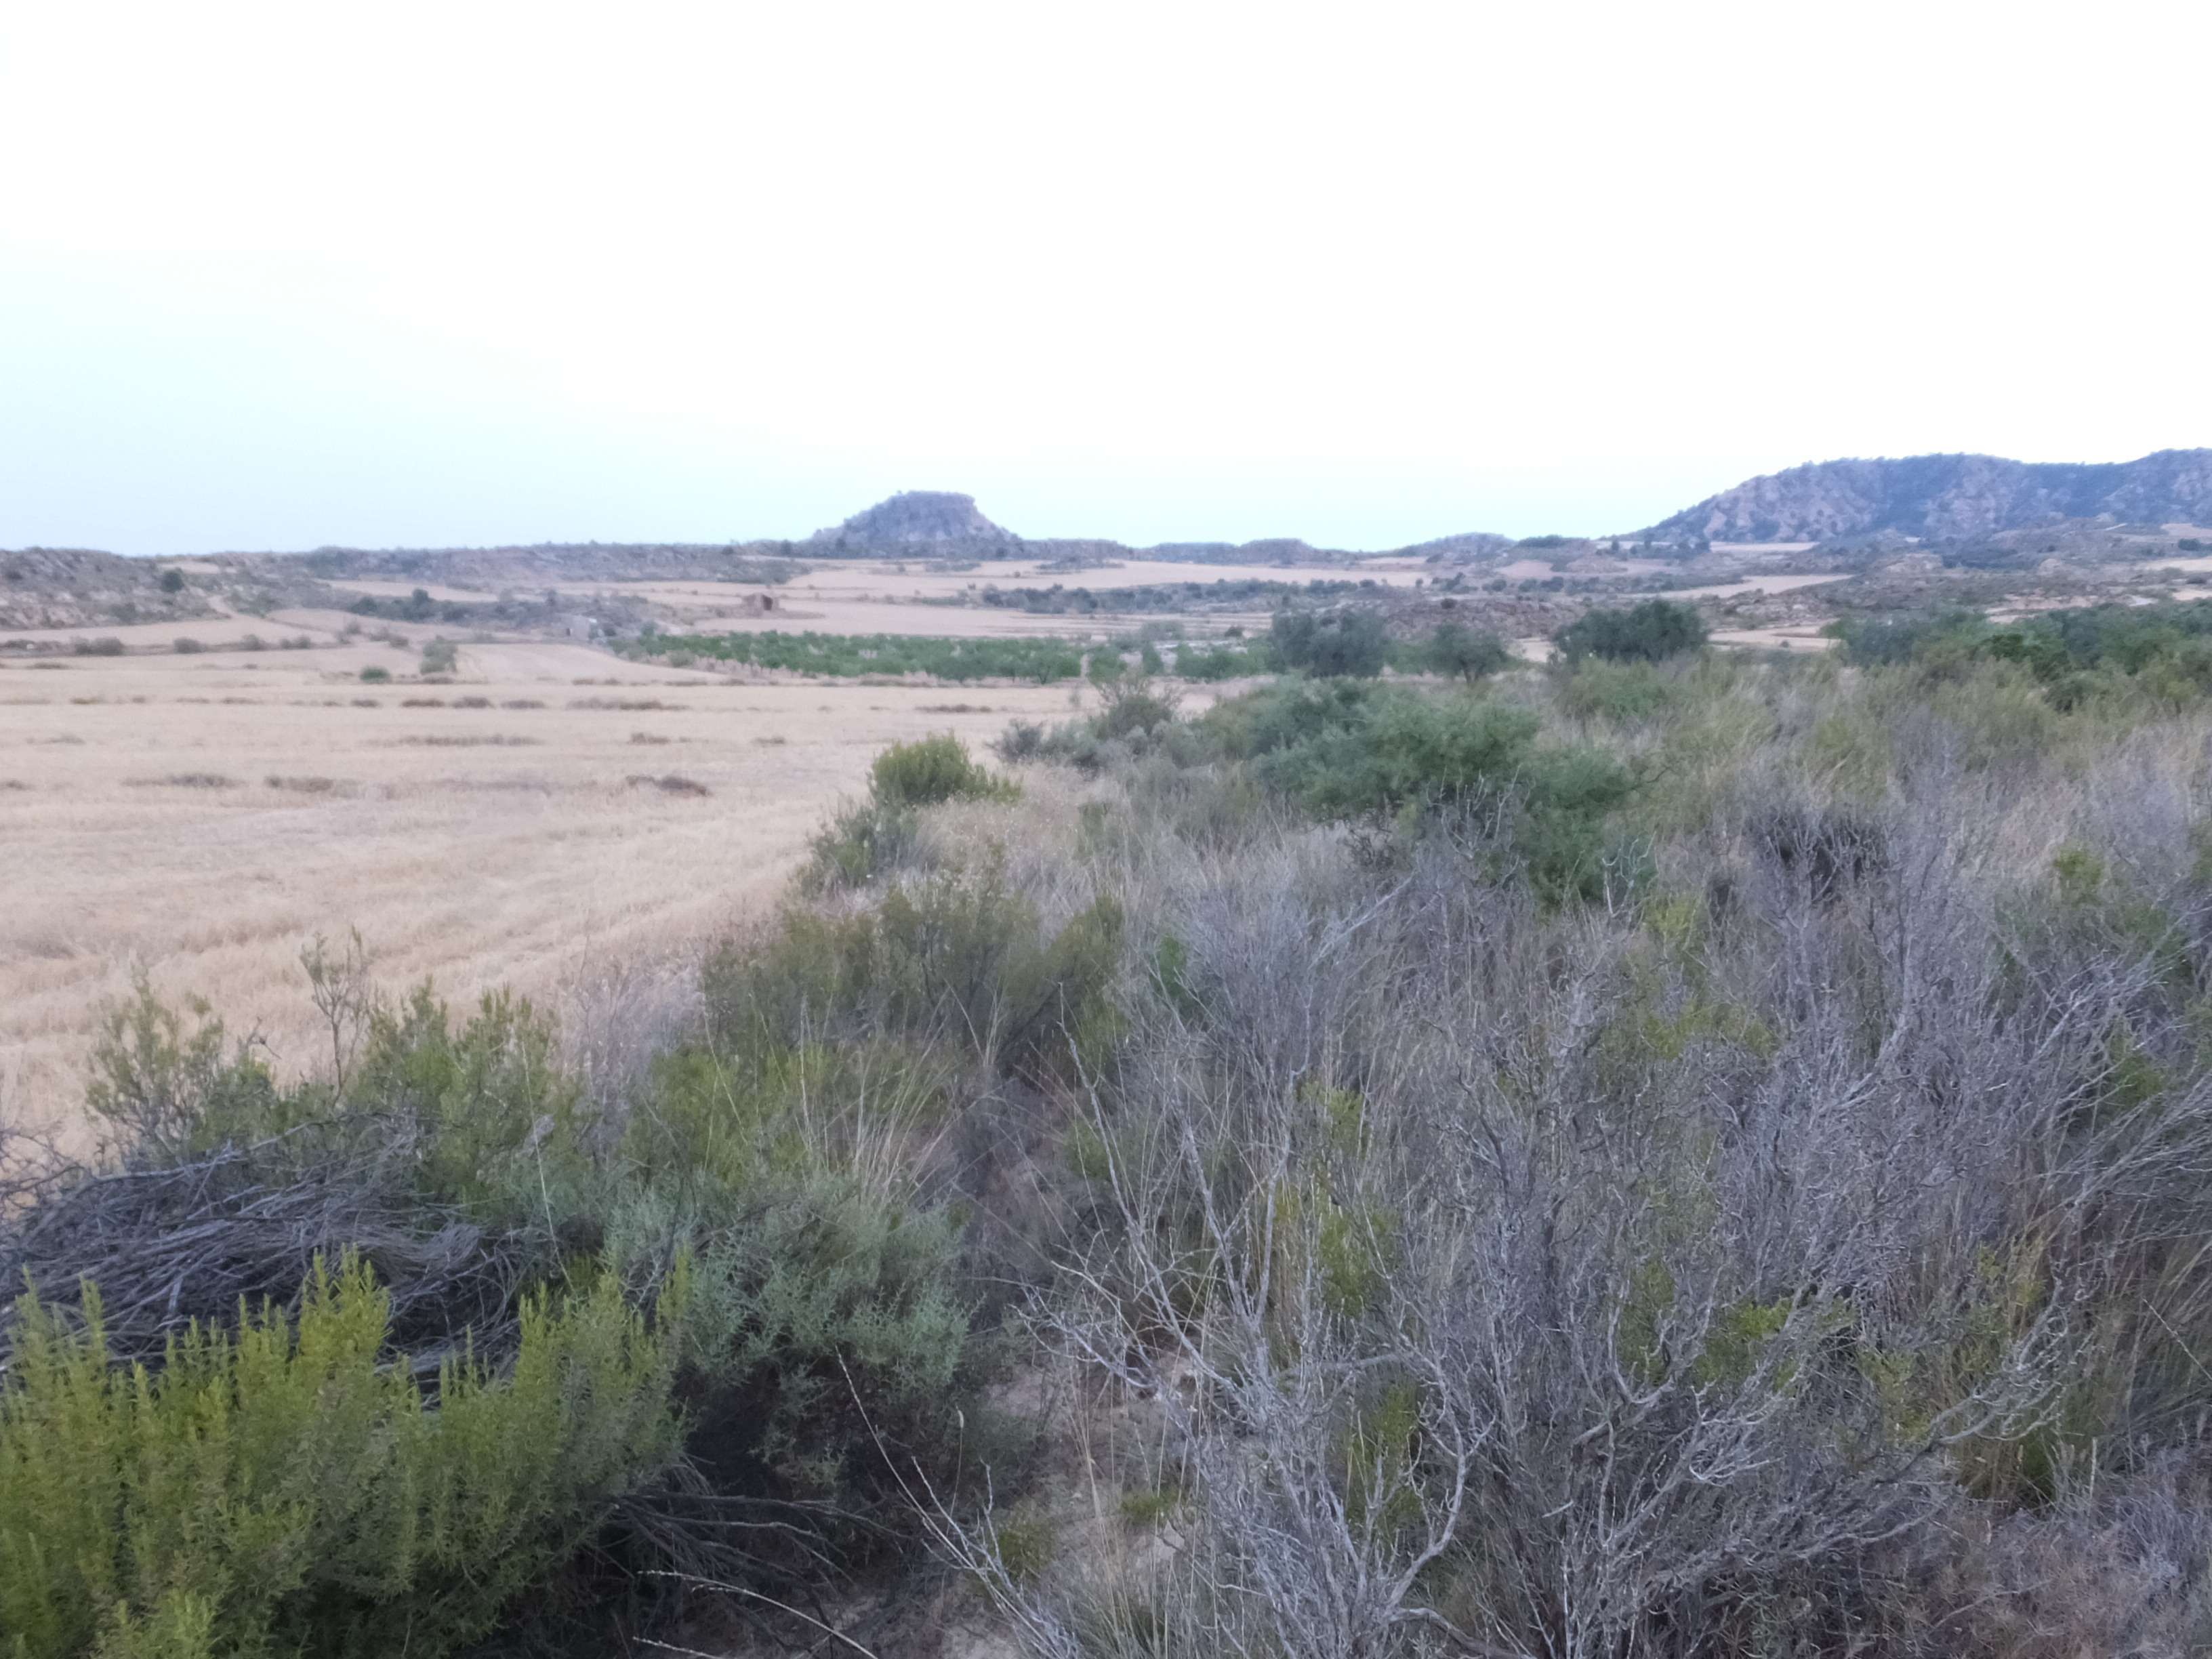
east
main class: Shrubland
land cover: Shrubland without tree cover
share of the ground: > 75 %
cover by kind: shrubs 75 %, herbaceous plants 25 %
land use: Semi-natural and natural areas not in use
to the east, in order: Shrubland without tree cover; Nuts trees; Shruby margins; Nuts trees; Shruby margins; Nuts trees; Shruby margins; Nuts trees; Shruby margins; Nuts trees; Shrubland without tree cover; Nuts trees
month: July
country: ES
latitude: 41.1647
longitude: -0.1070
